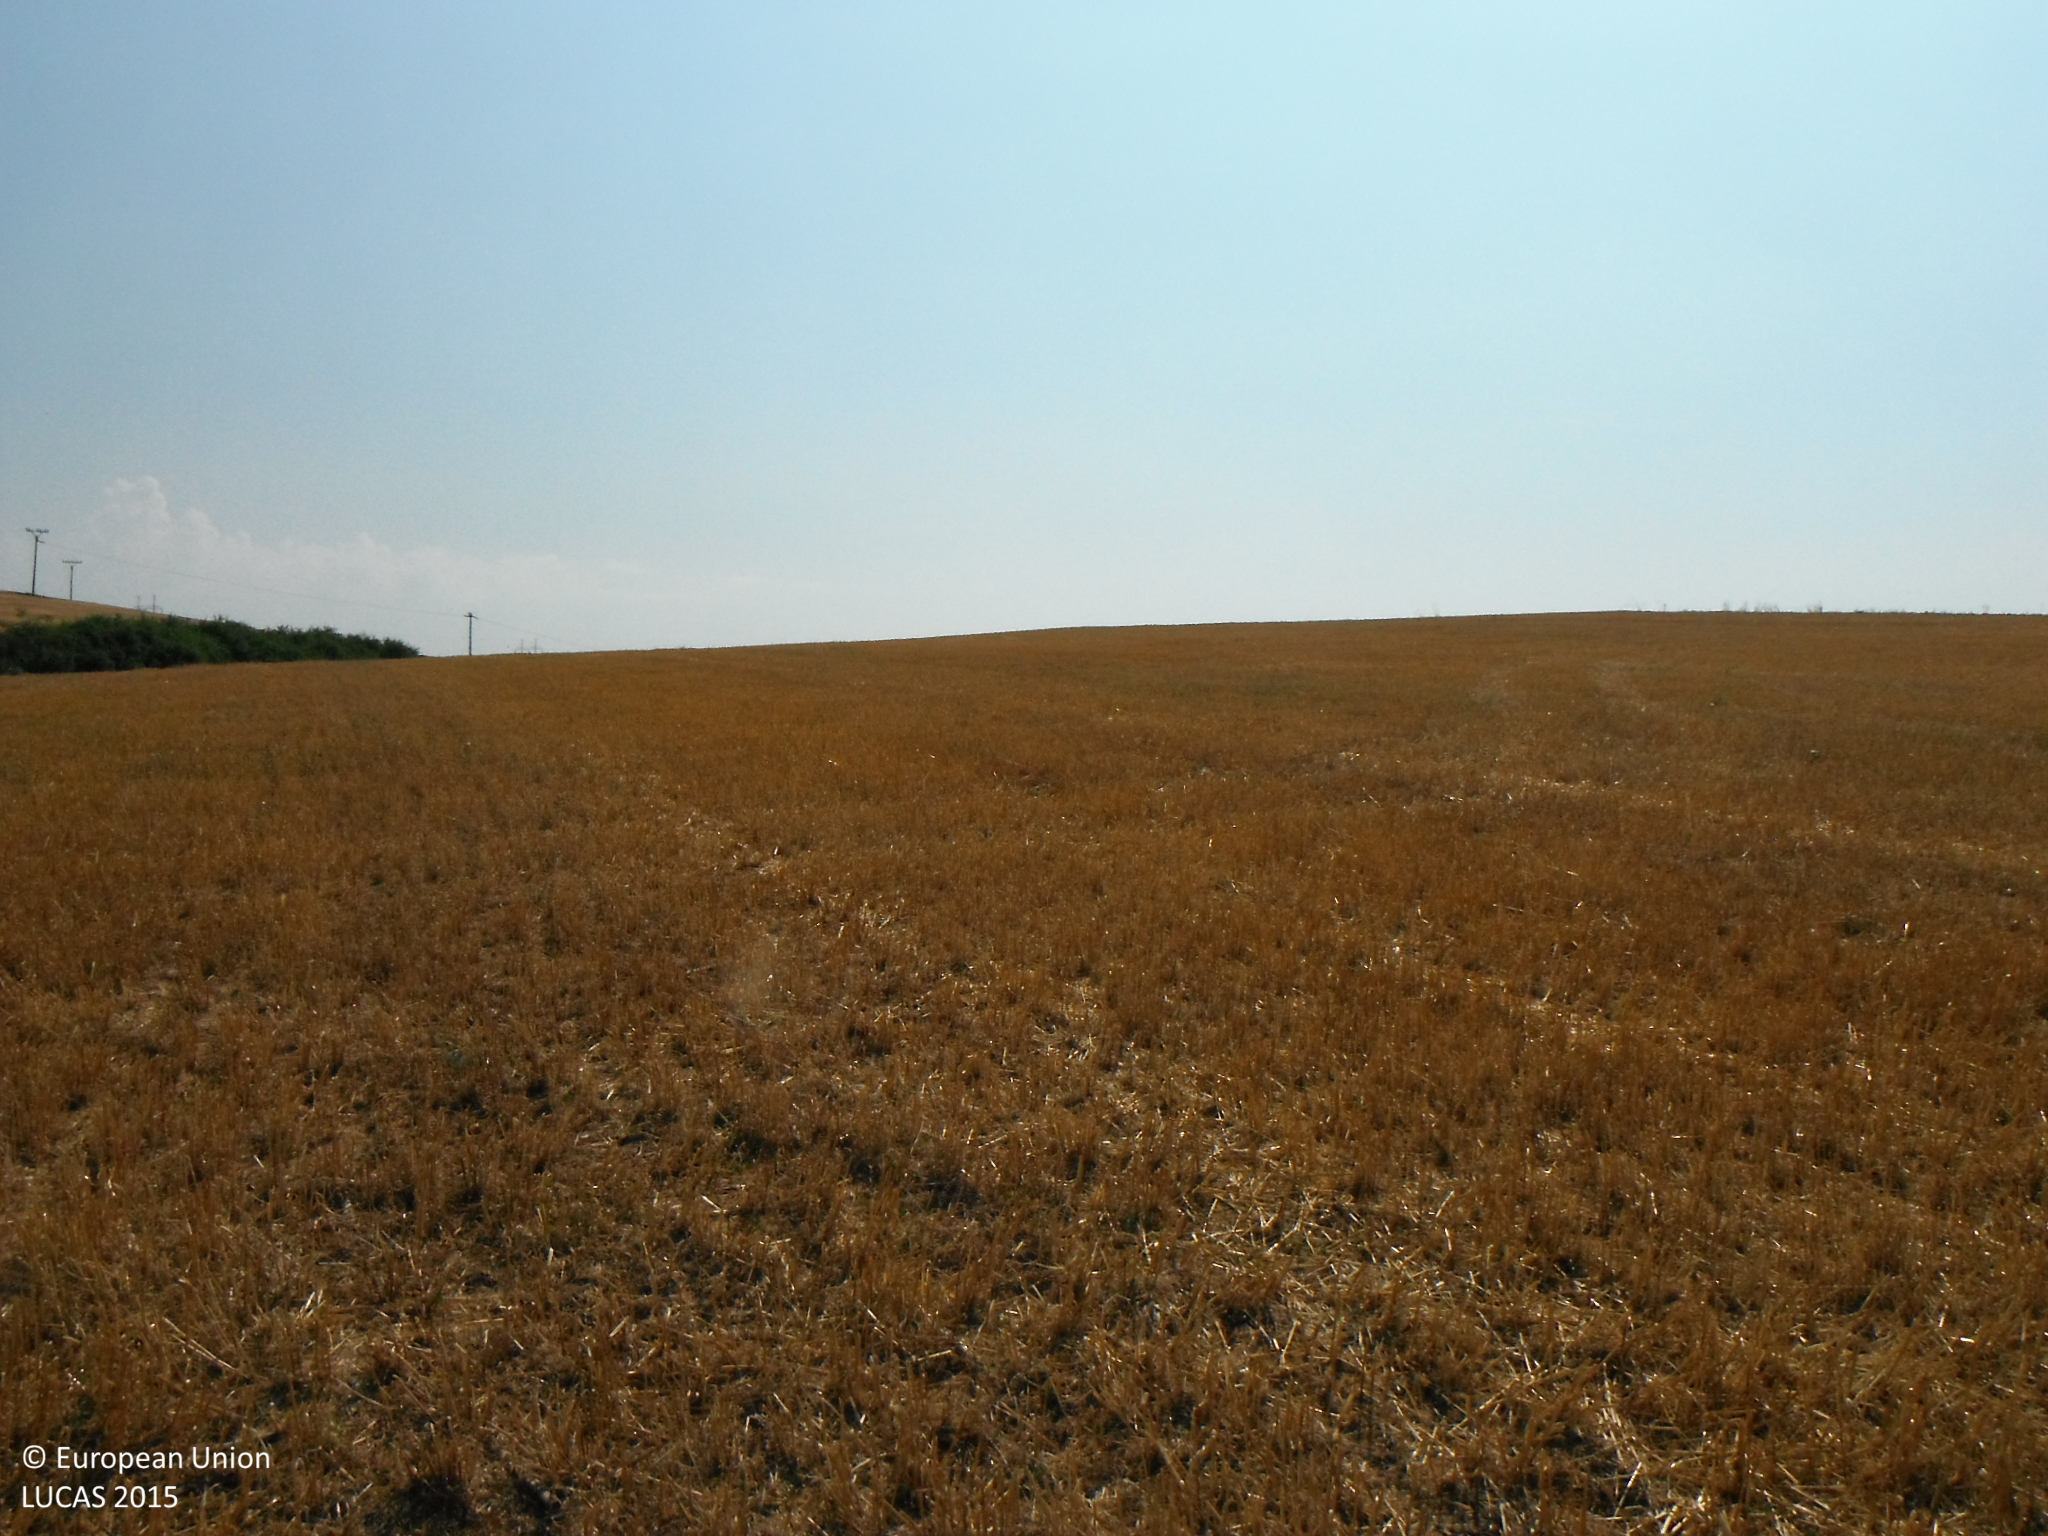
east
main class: Cropland
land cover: Barley
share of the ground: > 75 %
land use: Agriculture (excluding fallow land and kitchen gardens)
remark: Harvested field
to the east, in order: Barley; Spontaneously vegetated surfaces; Tracks; Grass margins; Grassland without tree/shrub cover; Tracks
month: July
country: SK
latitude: 48.3608
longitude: 20.0578
